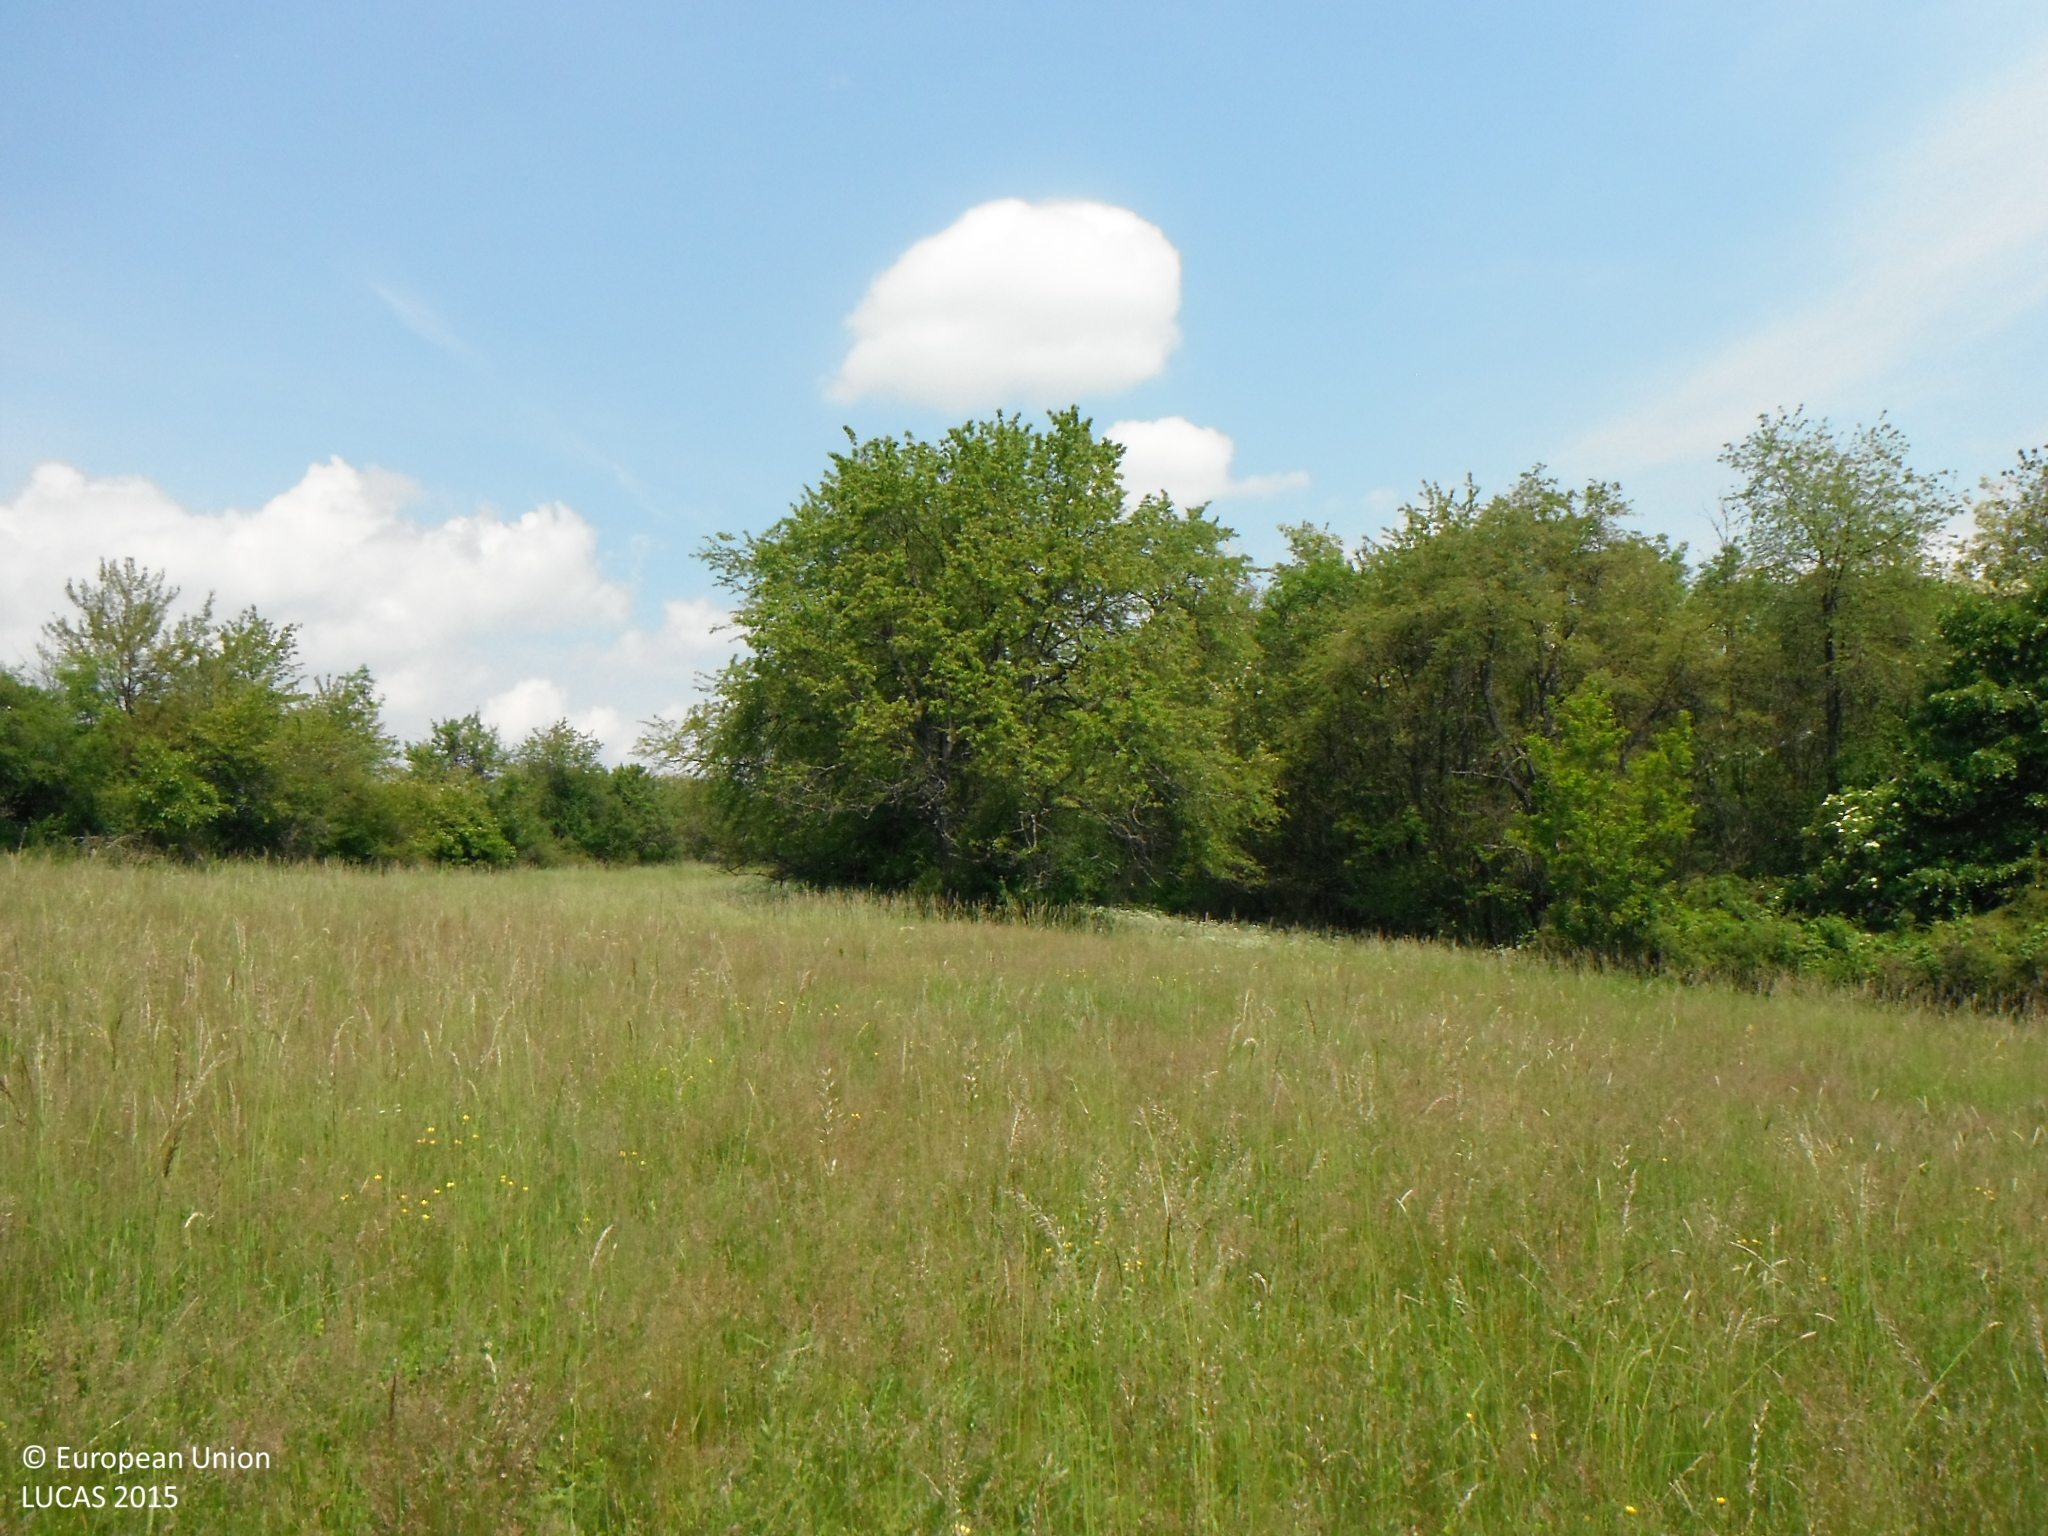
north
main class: Grassland
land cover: Grassland without tree/shrub cover
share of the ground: > 75 %
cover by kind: herbaceous plants 100 %
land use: Agriculture (excluding fallow land and kitchen gardens)
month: June
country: SK
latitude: 48.3262
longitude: 19.4246
